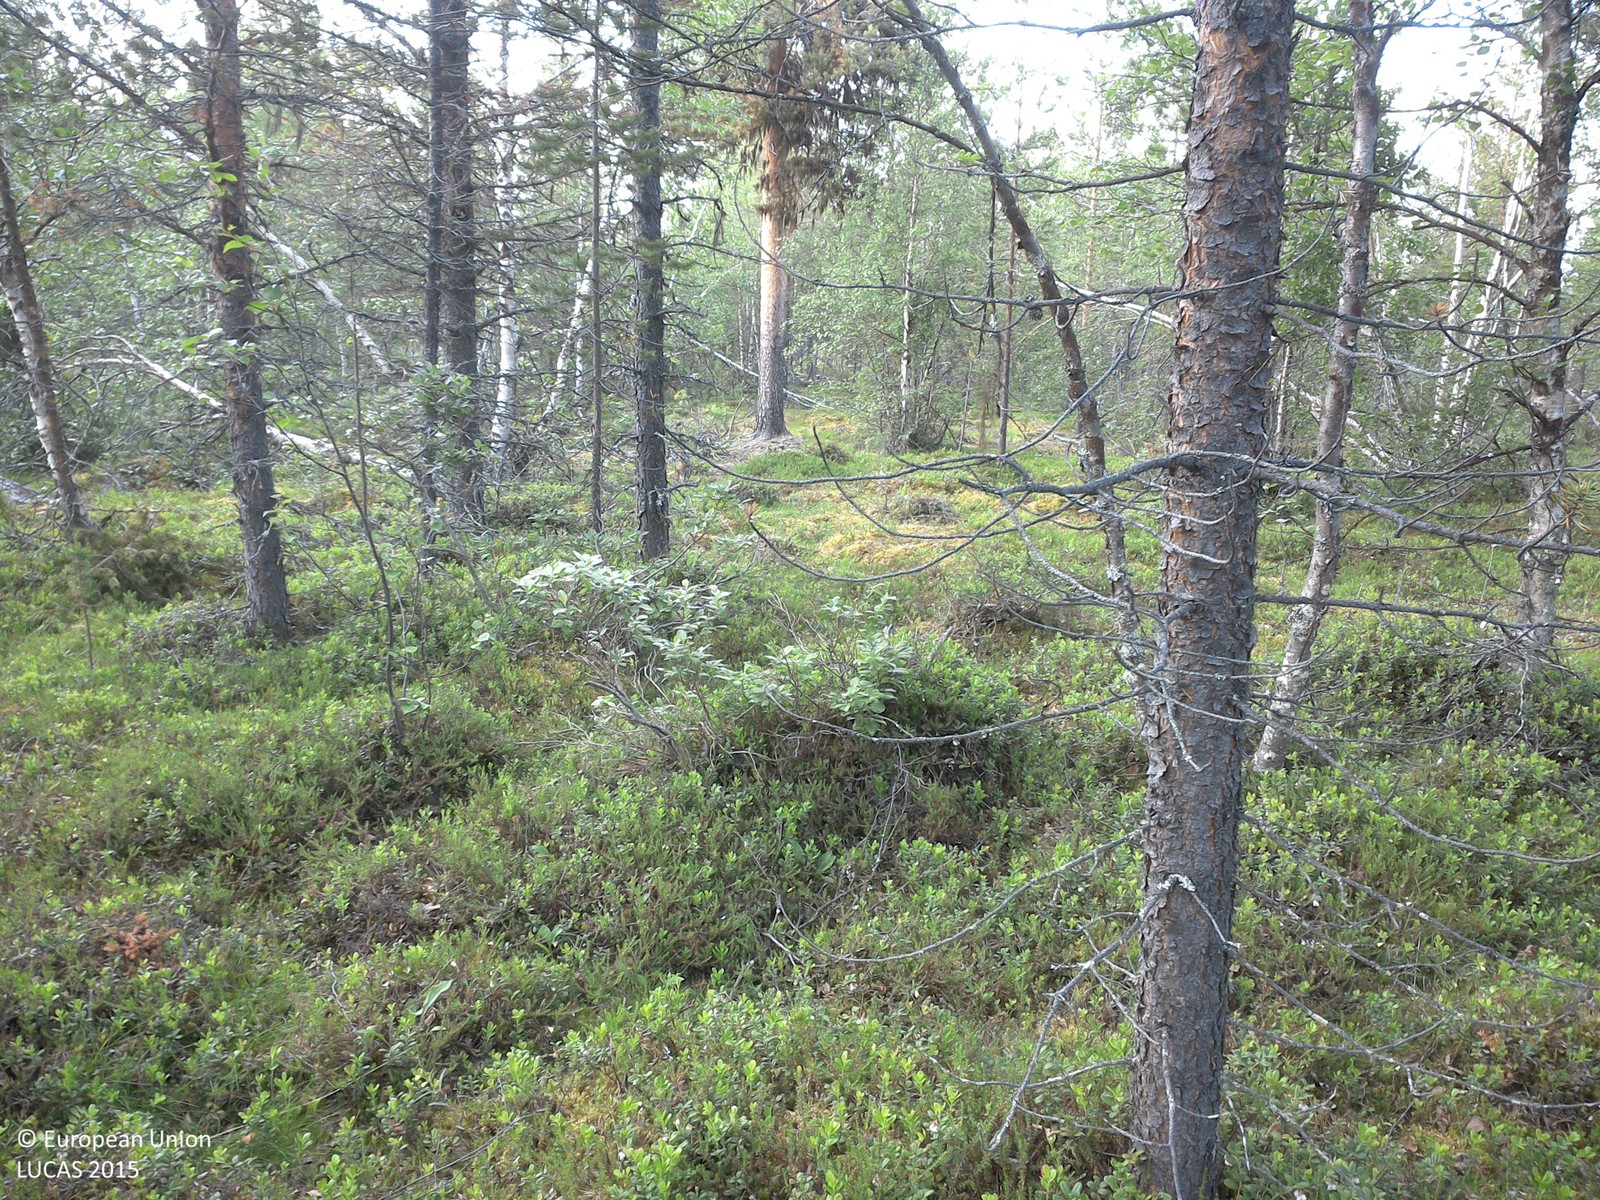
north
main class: Woodland
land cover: Pine dominated mixed woodland
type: boreal forest
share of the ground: 25 - 50 %
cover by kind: shrubs 55 %, coniferous forest trees 20 %, broadleaved forest trees 15 %, lichens and mosses 10 %
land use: Forestry
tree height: > 5 m
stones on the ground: < 10 %
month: July
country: SE
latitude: 67.8480
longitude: 22.2848
